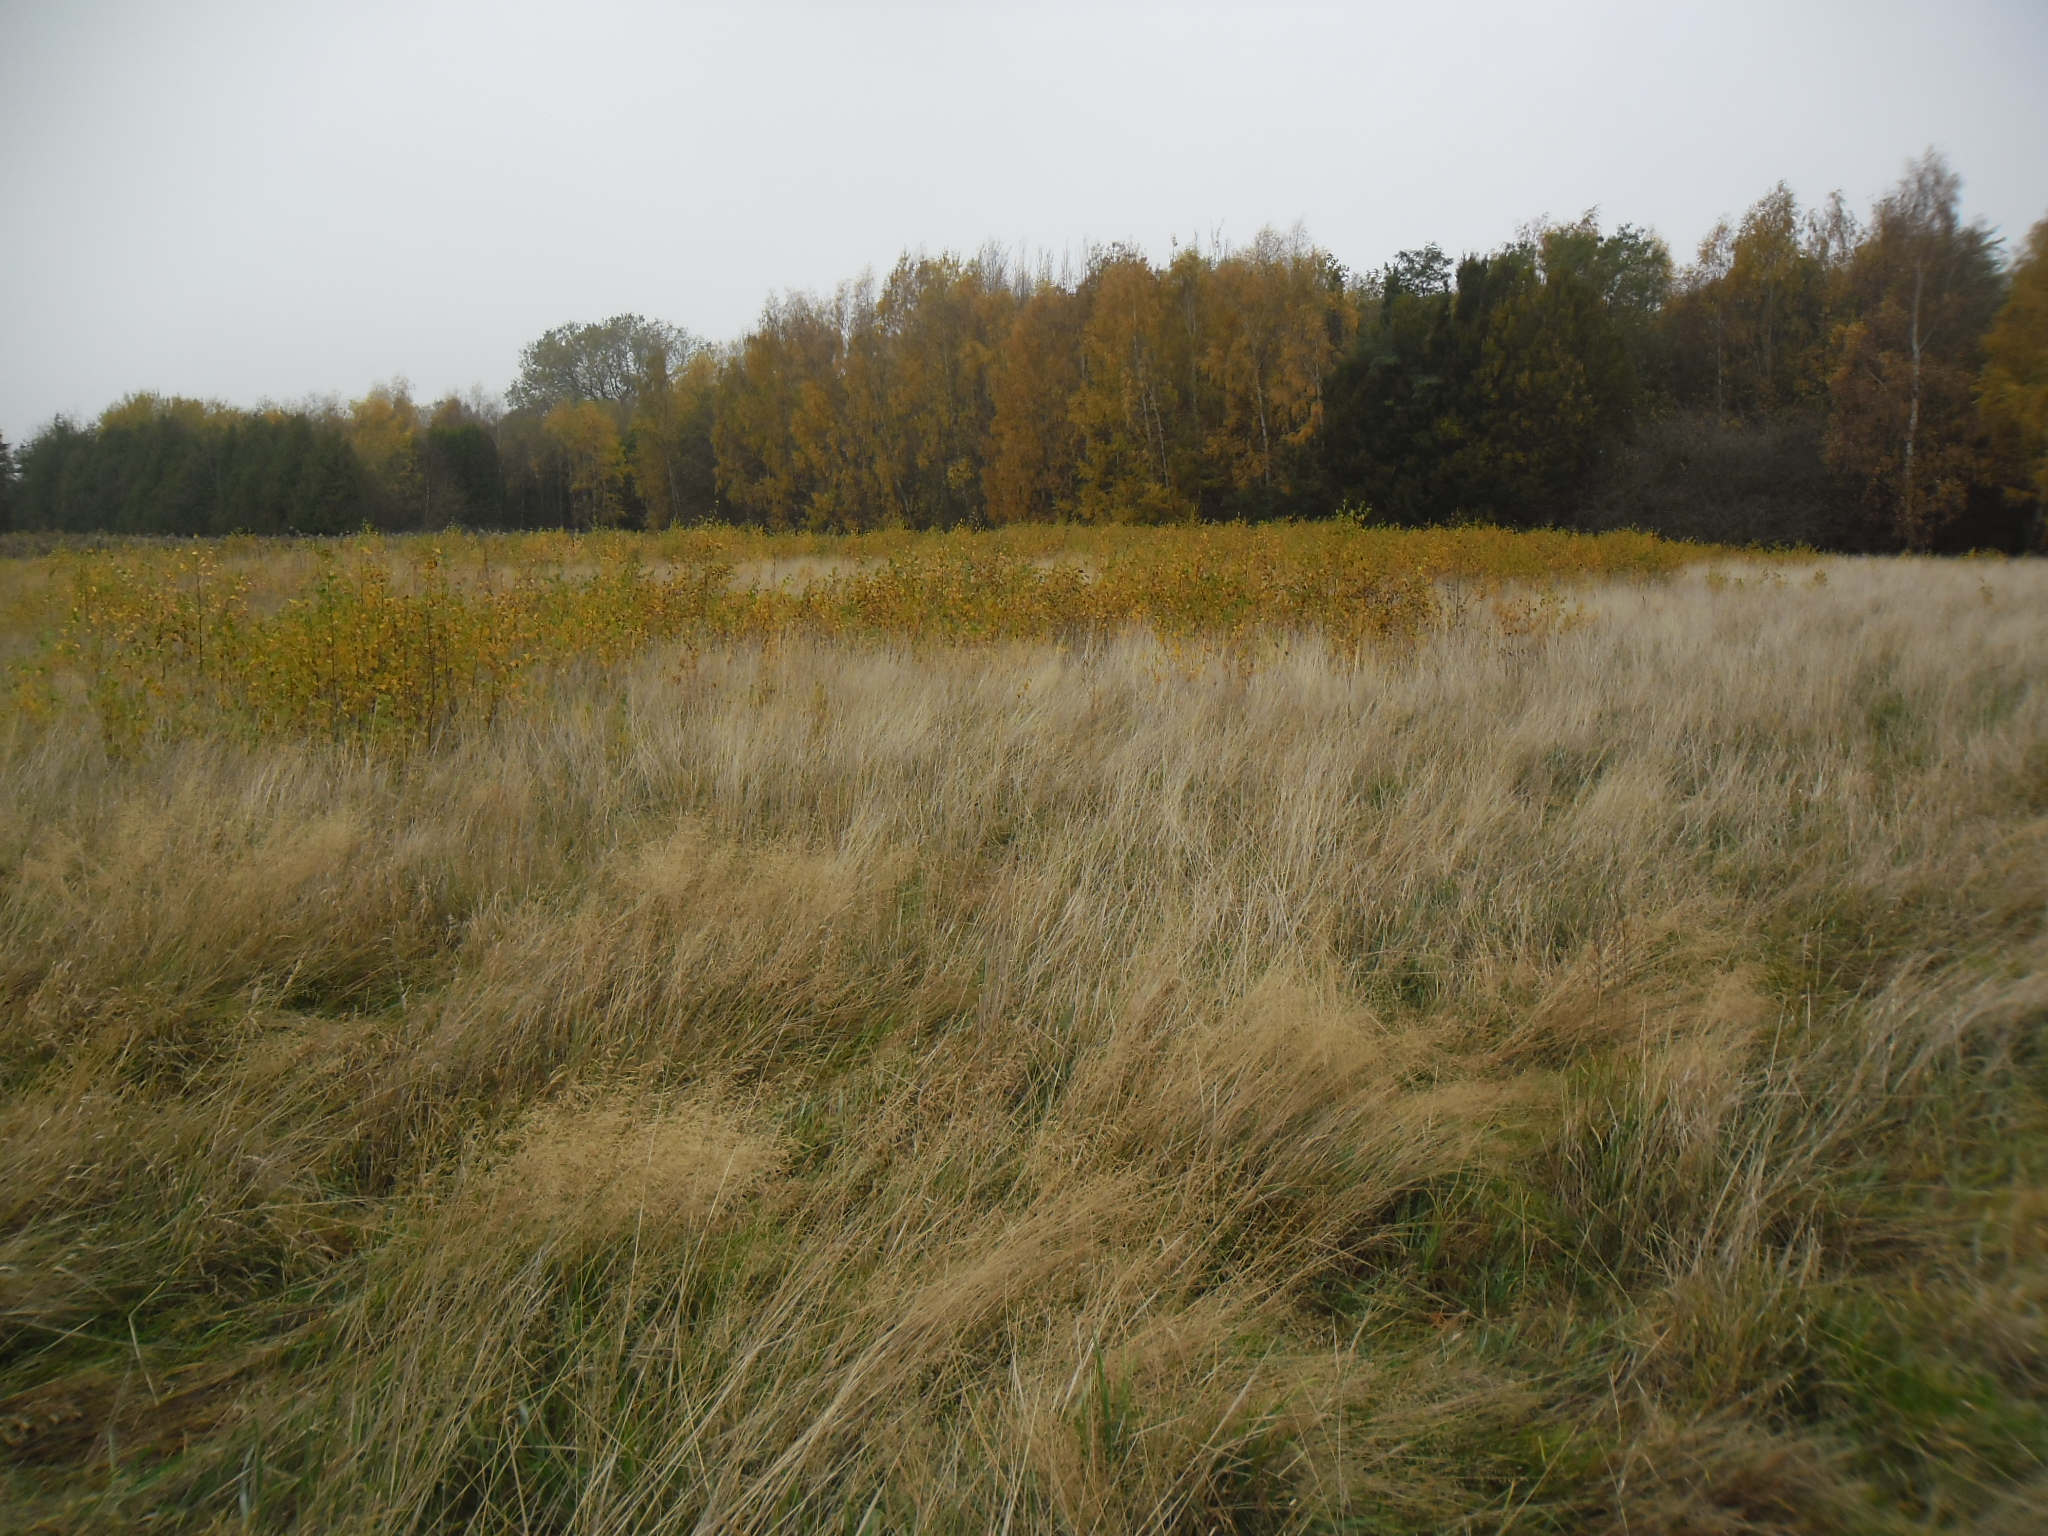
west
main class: Grassland
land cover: Grassland without tree/shrub cover
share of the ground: > 75 %
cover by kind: herbaceous plants 100 %
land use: Agriculture (excluding fallow land and kitchen gardens)
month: November
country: SE
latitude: 56.2281
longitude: 12.8524
